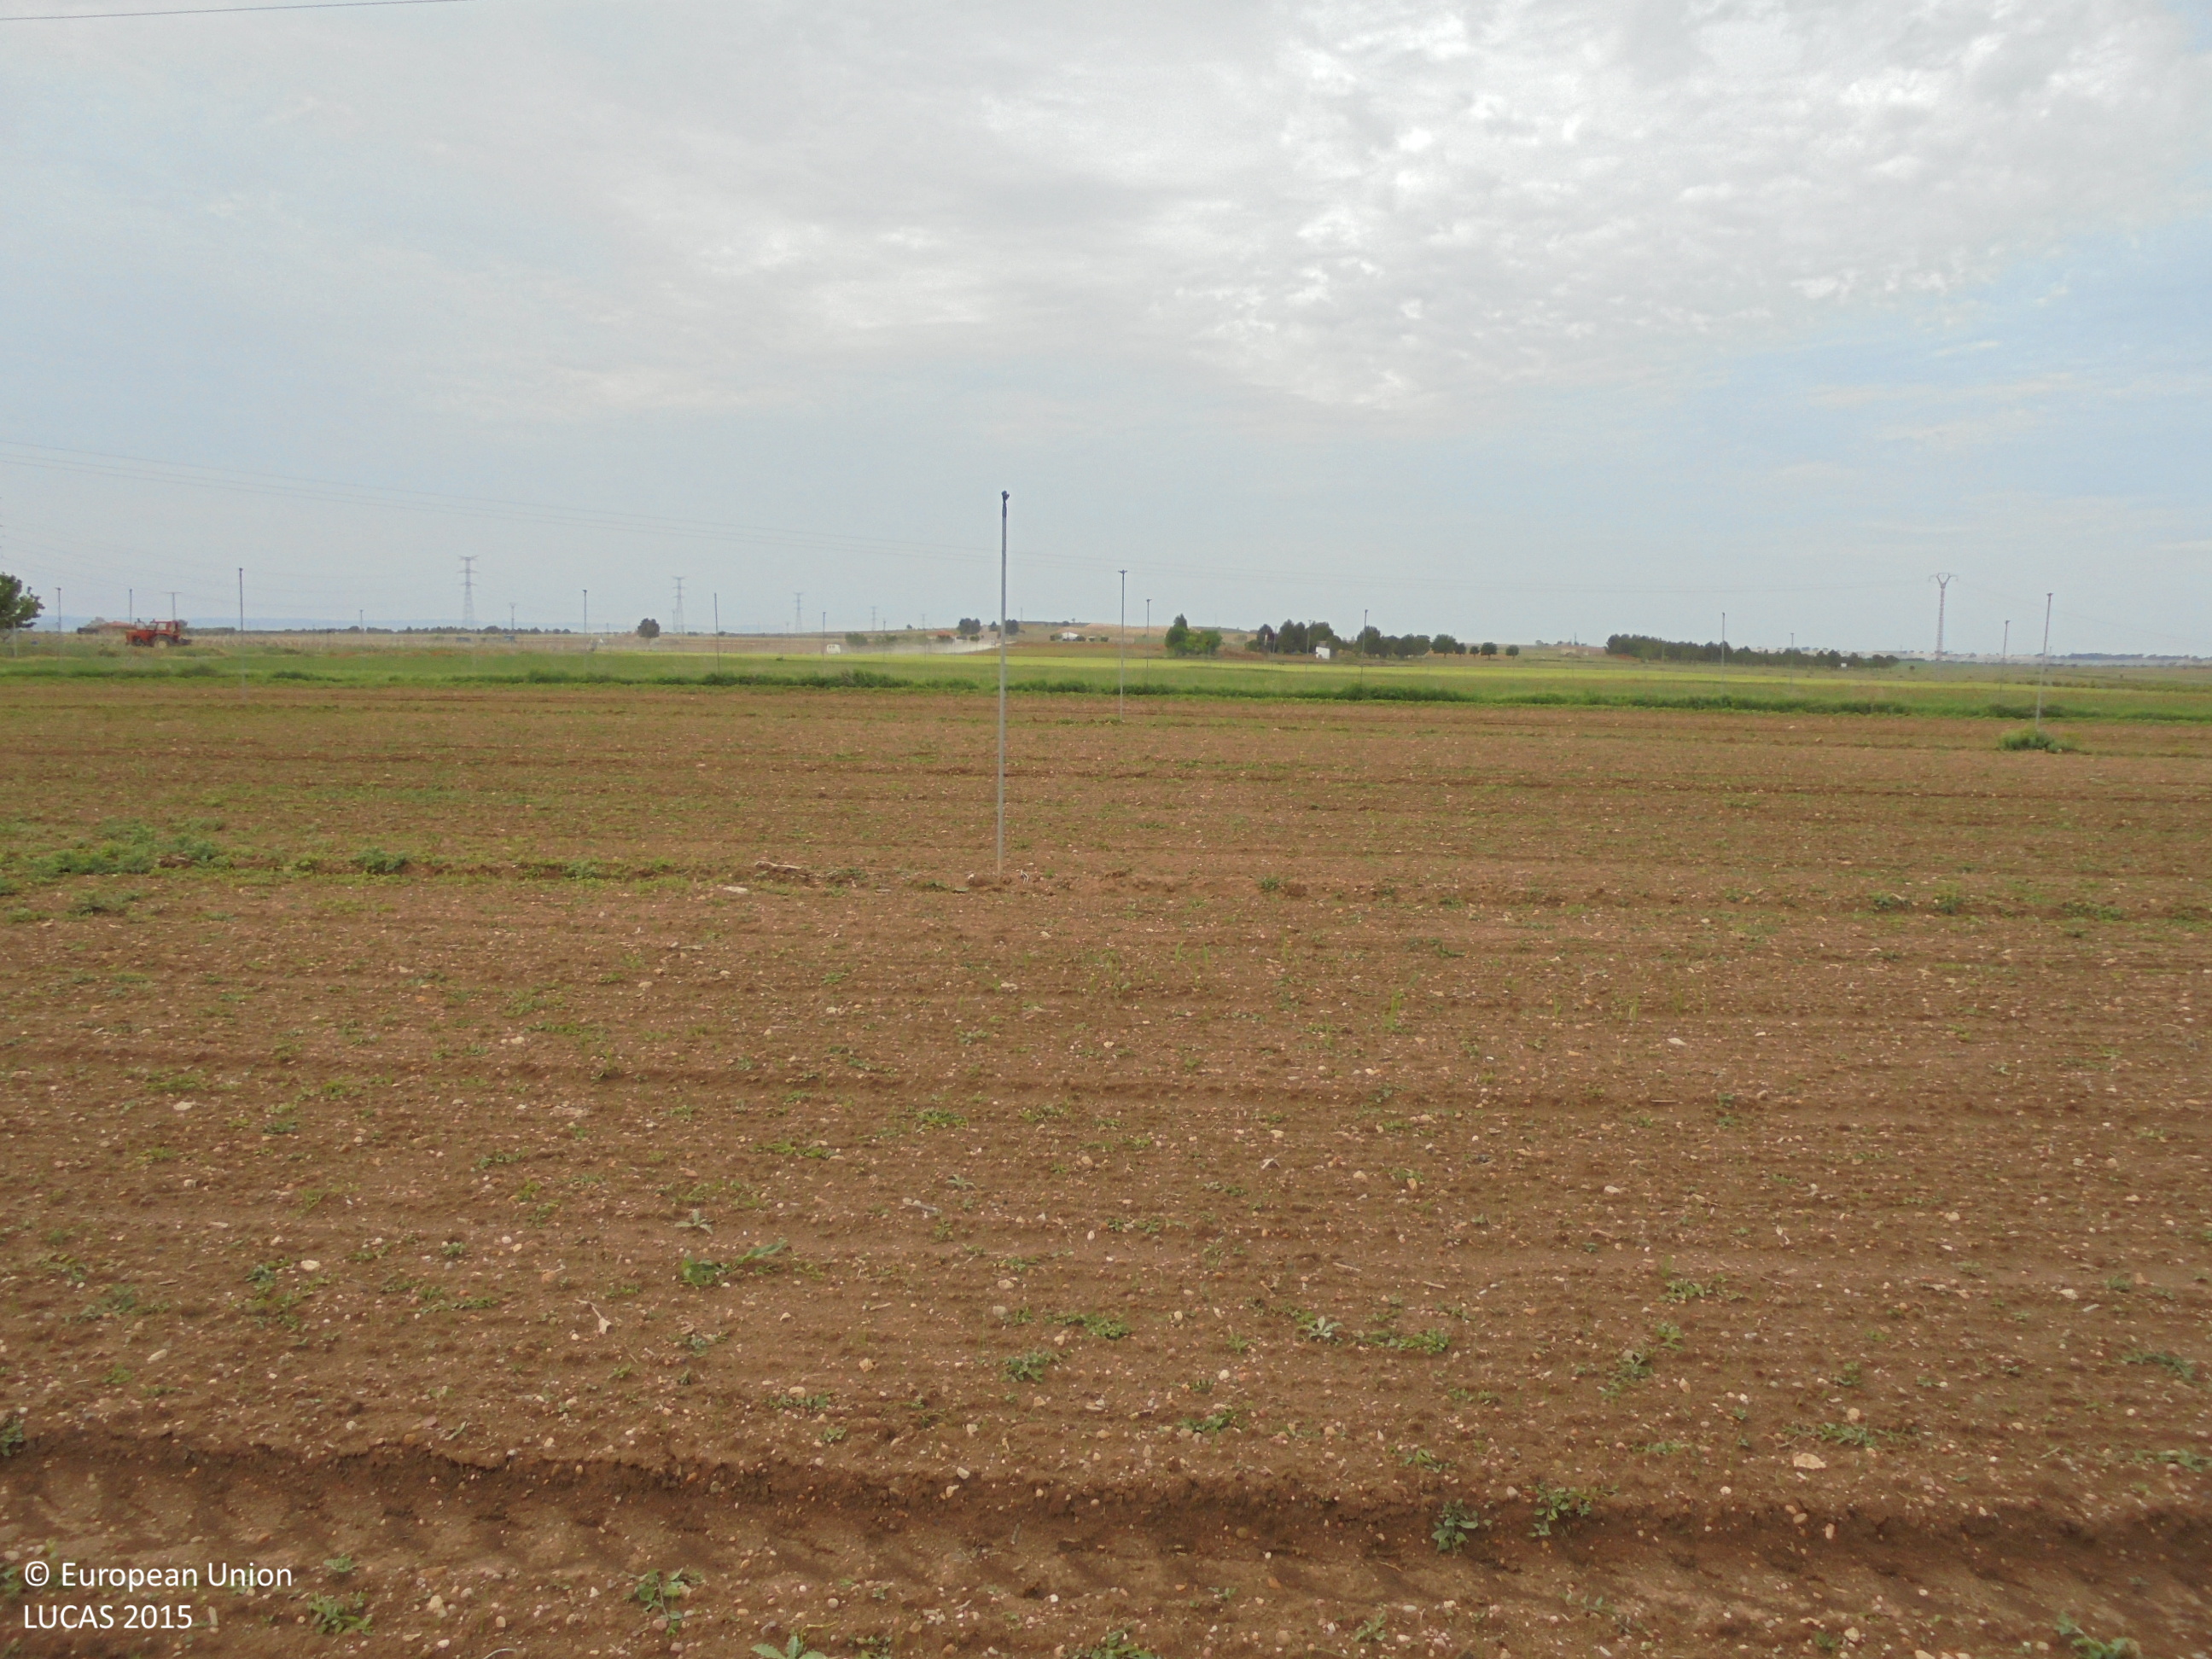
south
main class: Cropland
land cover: Other root crops
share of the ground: < 10 %
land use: Agriculture (excluding fallow land and kitchen gardens)
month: May
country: ES
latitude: 39.2257
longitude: -1.7833
